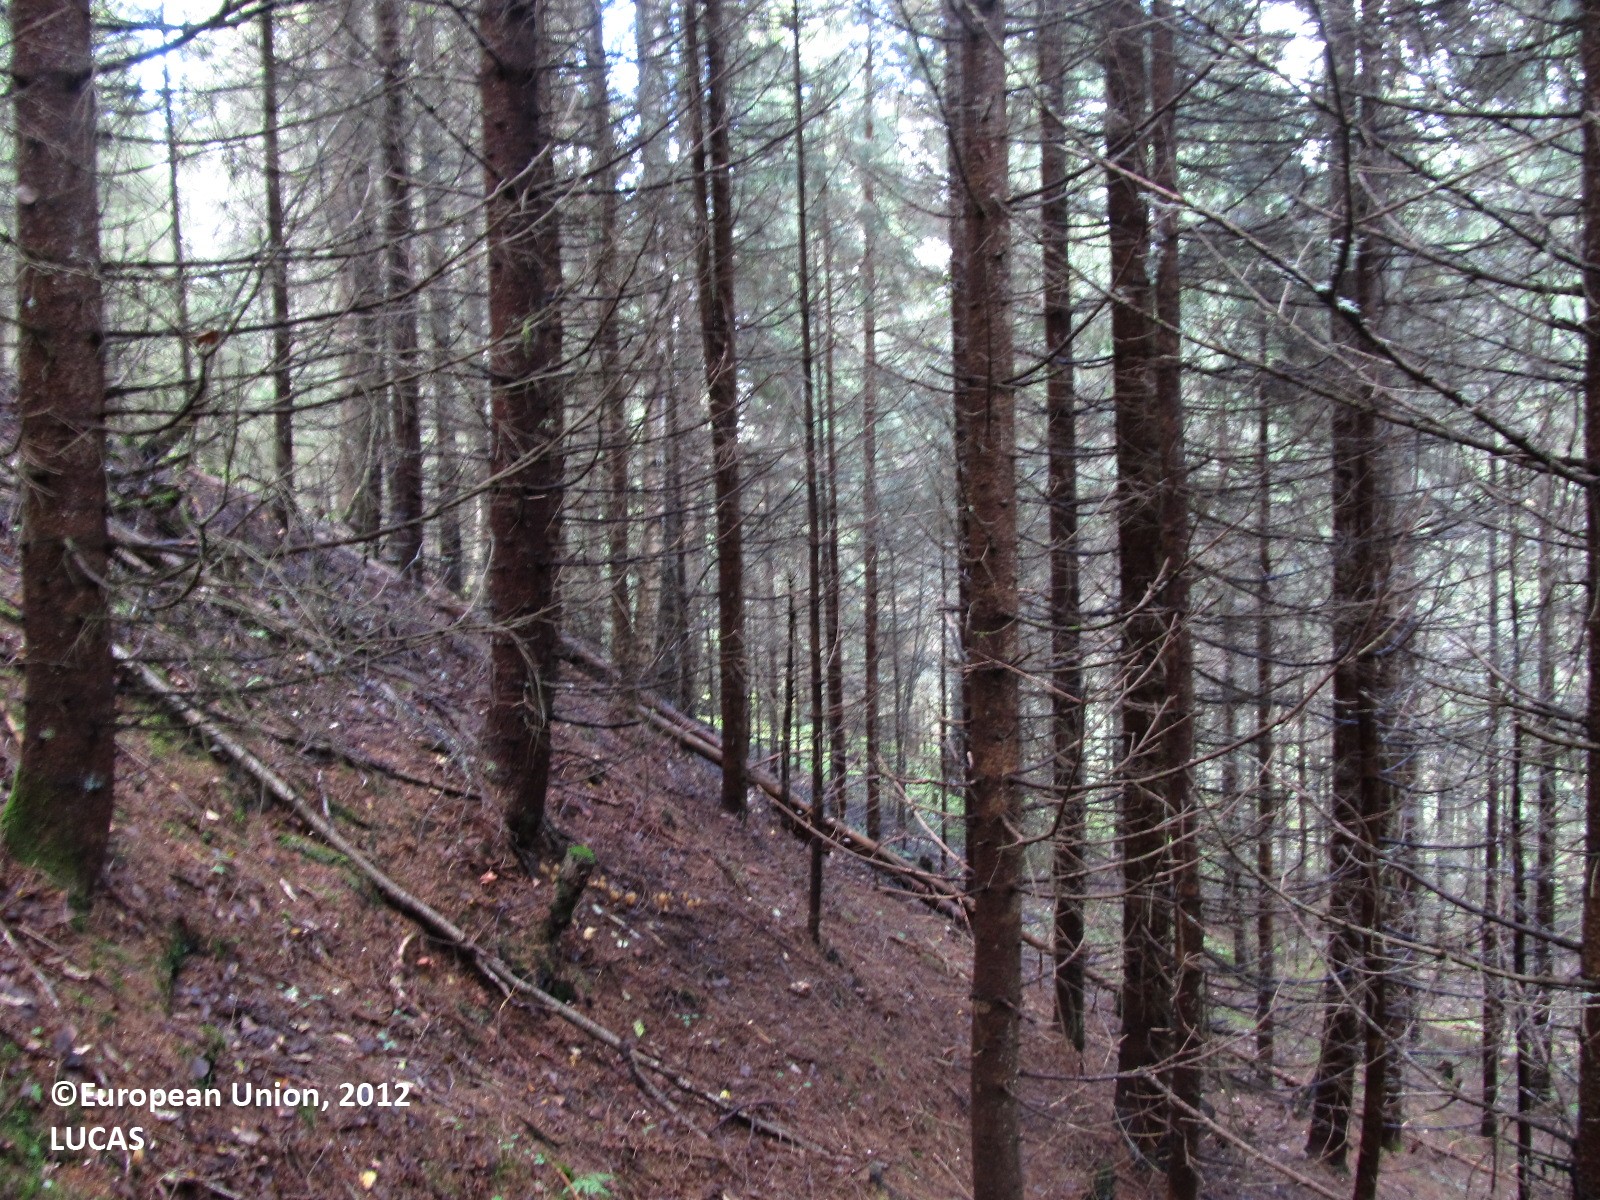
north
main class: Woodland
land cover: Spruce dominated coniferous woodland
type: boreal forest
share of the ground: > 75 %
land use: Forestry
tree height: > 5 m
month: September
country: FI
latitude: 63.2365
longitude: 28.3607
